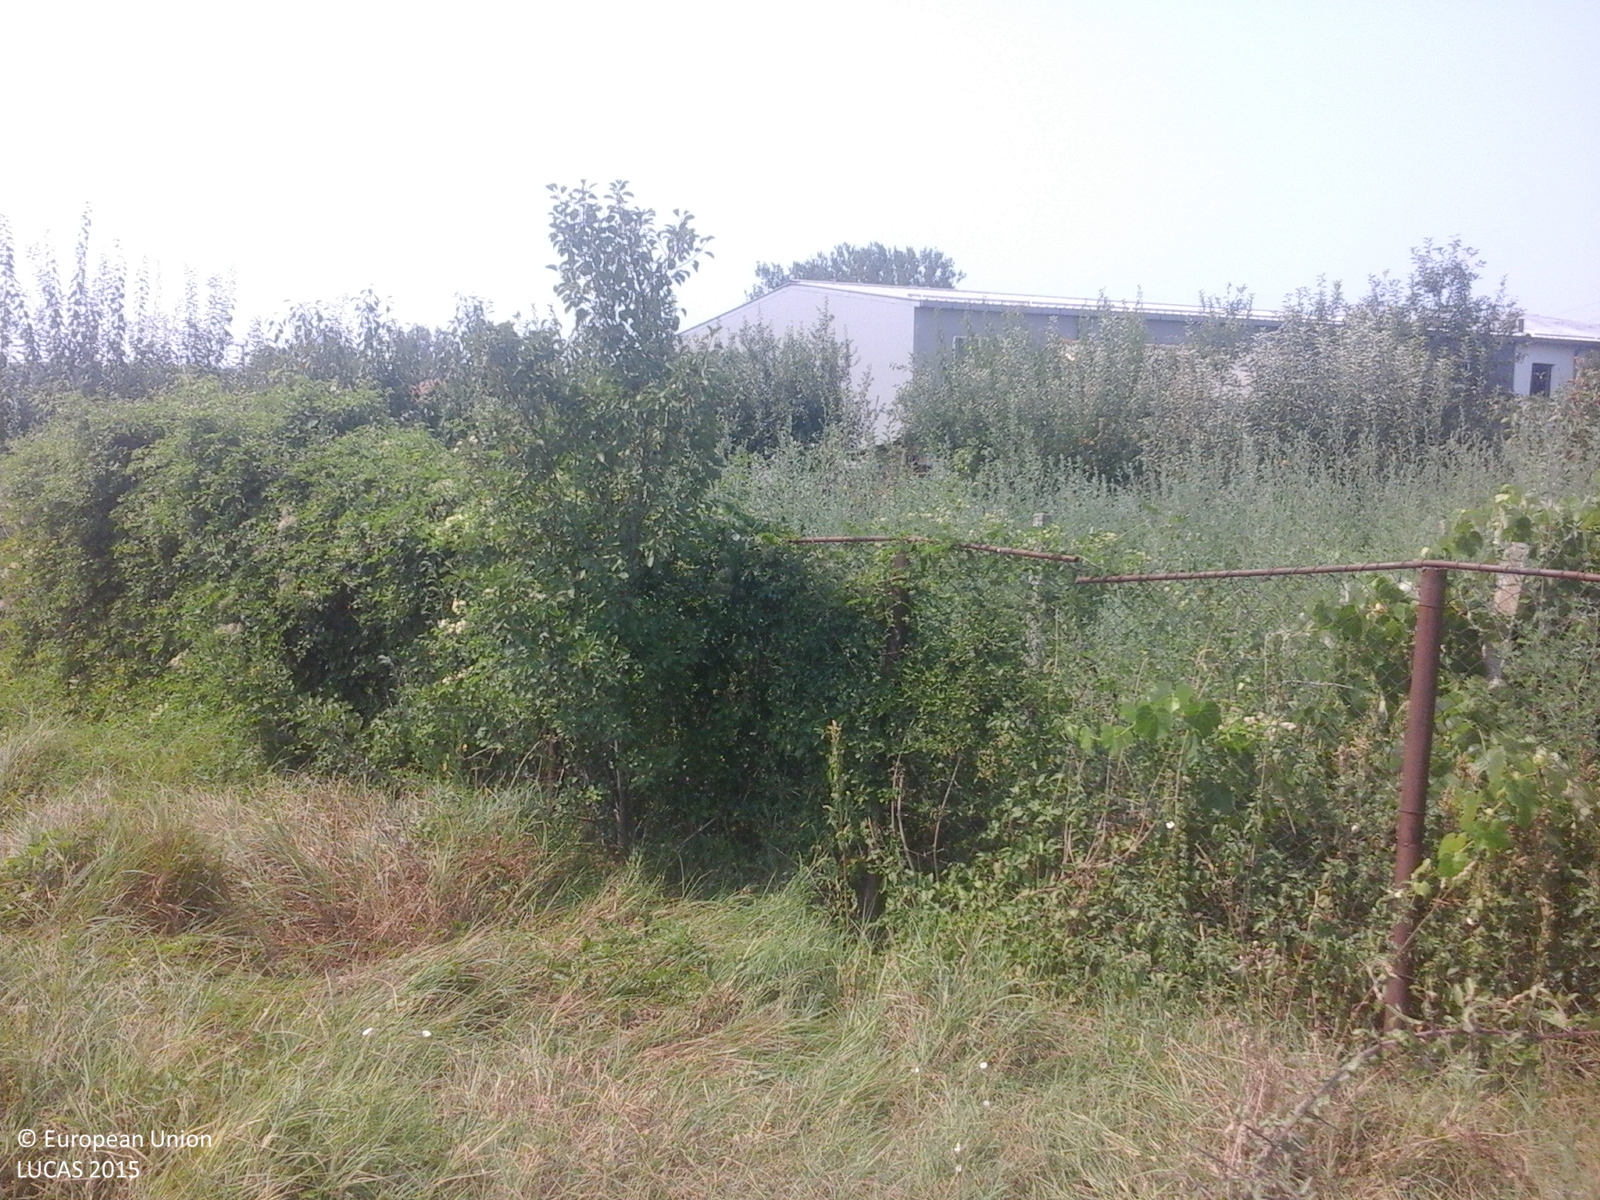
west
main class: Cropland
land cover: Vineyards
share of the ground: > 75 %
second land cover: Grassland without tree/shrub cover
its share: 10 - 25 %
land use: Agriculture (excluding fallow land and kitchen gardens)
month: August
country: RO
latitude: 44.2644
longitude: 23.7980
